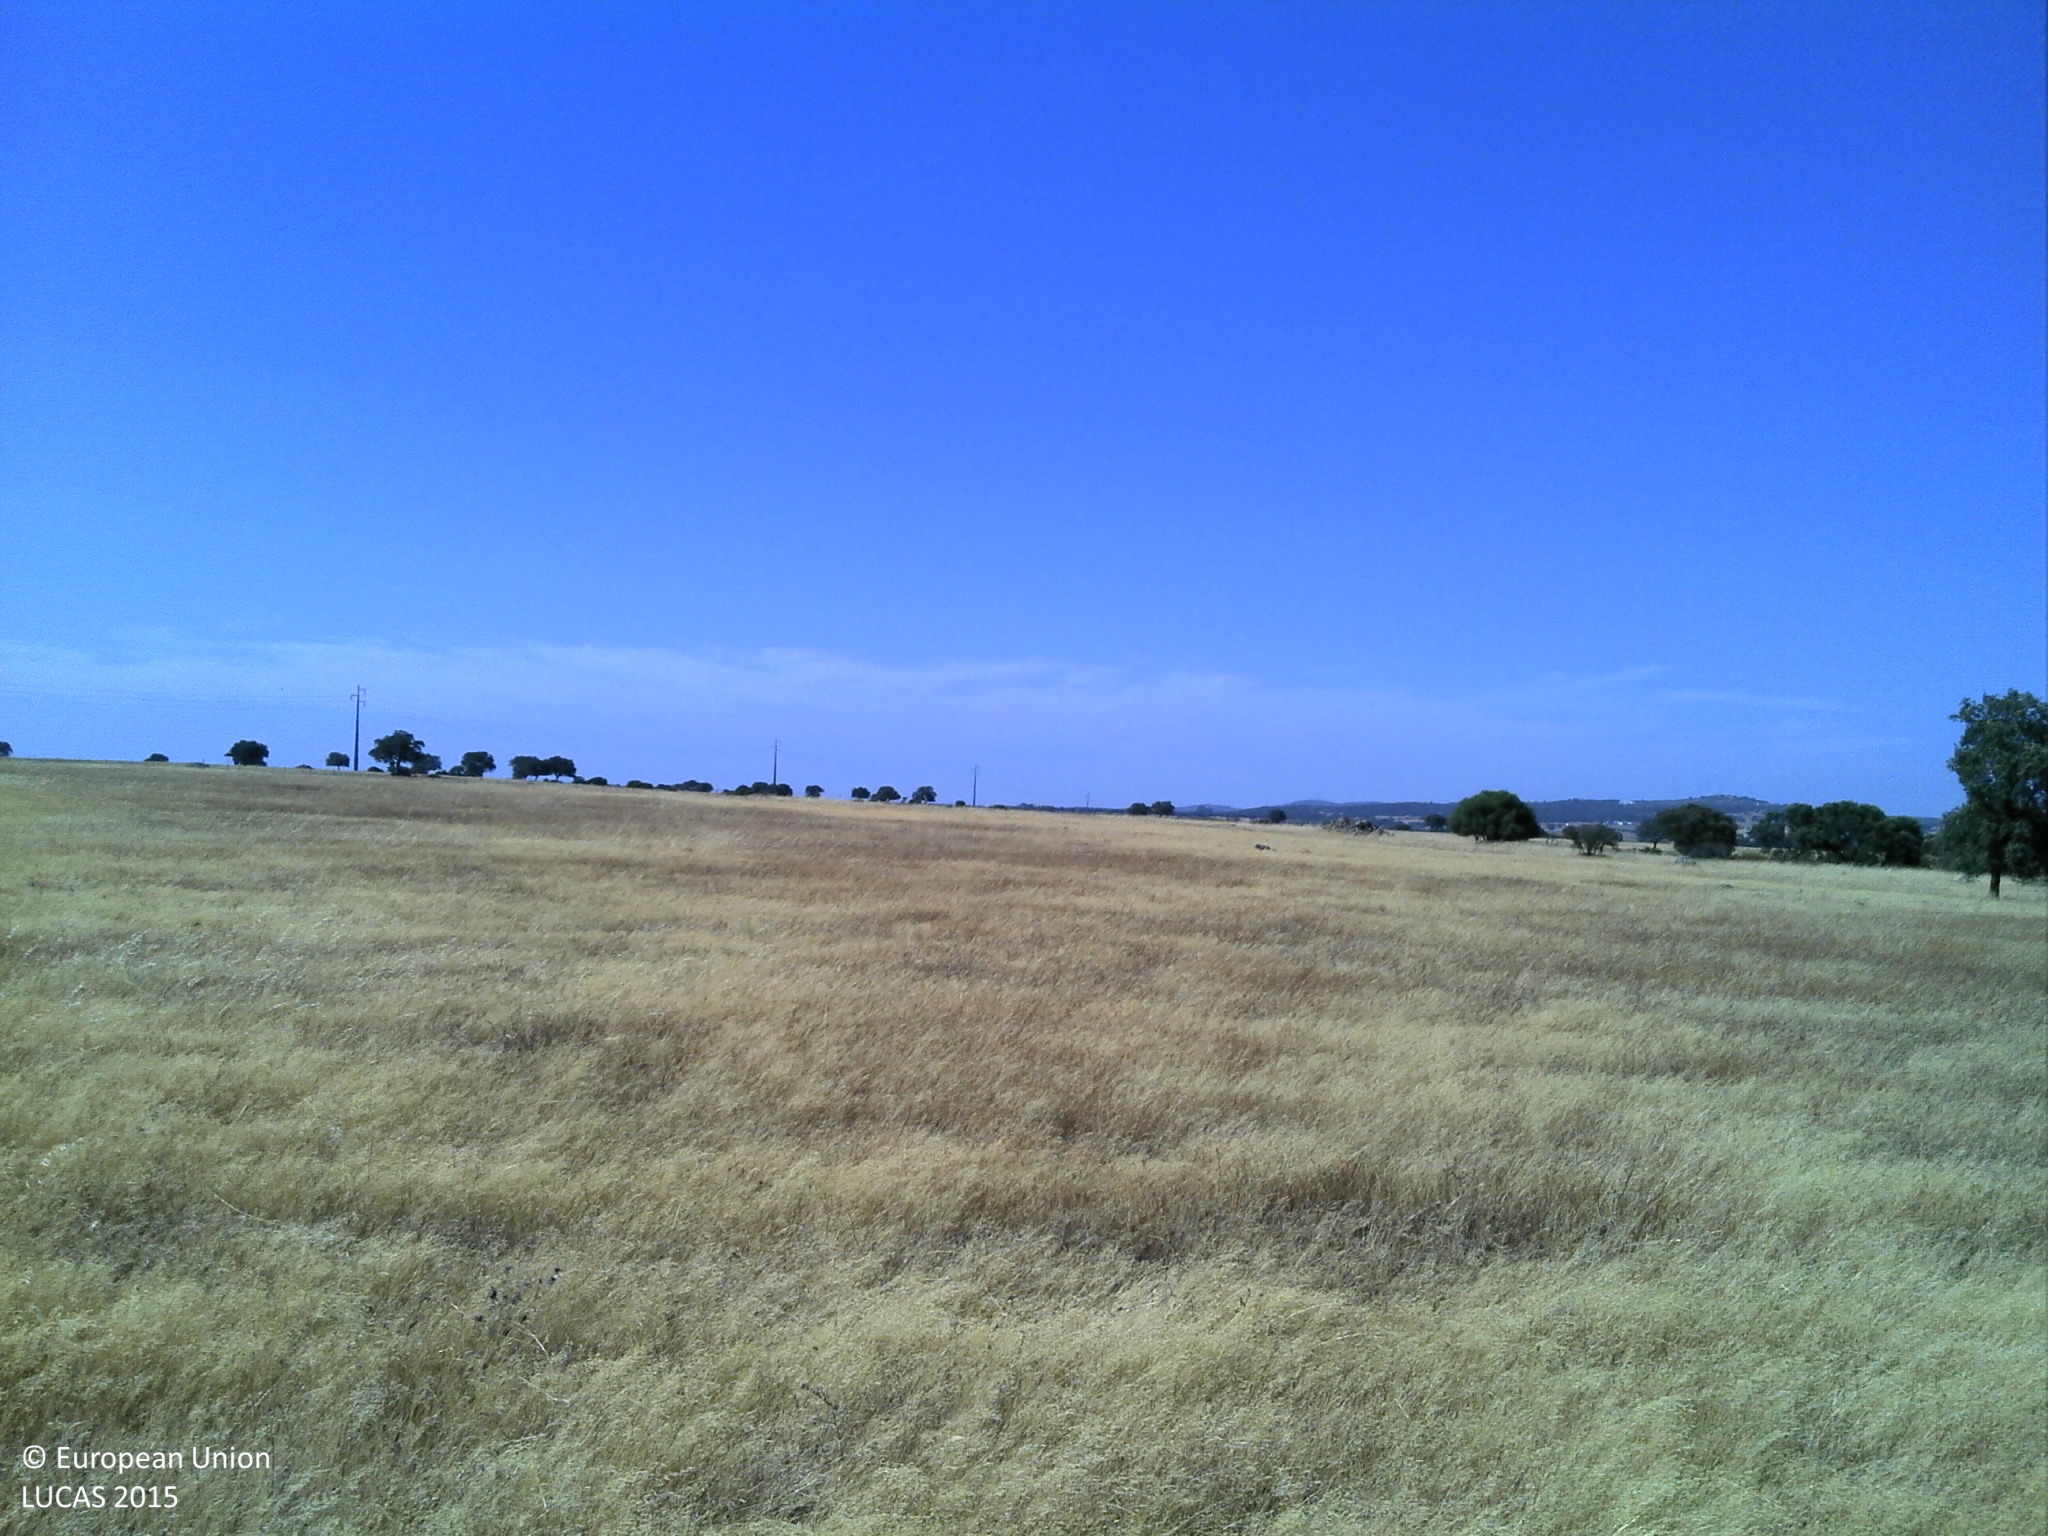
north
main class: Grassland
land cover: Grassland without tree/shrub cover
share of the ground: > 75 %
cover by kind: herbaceous plants 85 %, unconsolidated bare surface 15 %
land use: Agriculture (excluding fallow land and kitchen gardens)
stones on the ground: < 10 %
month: June
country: PT
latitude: 38.2084
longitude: -8.0458
